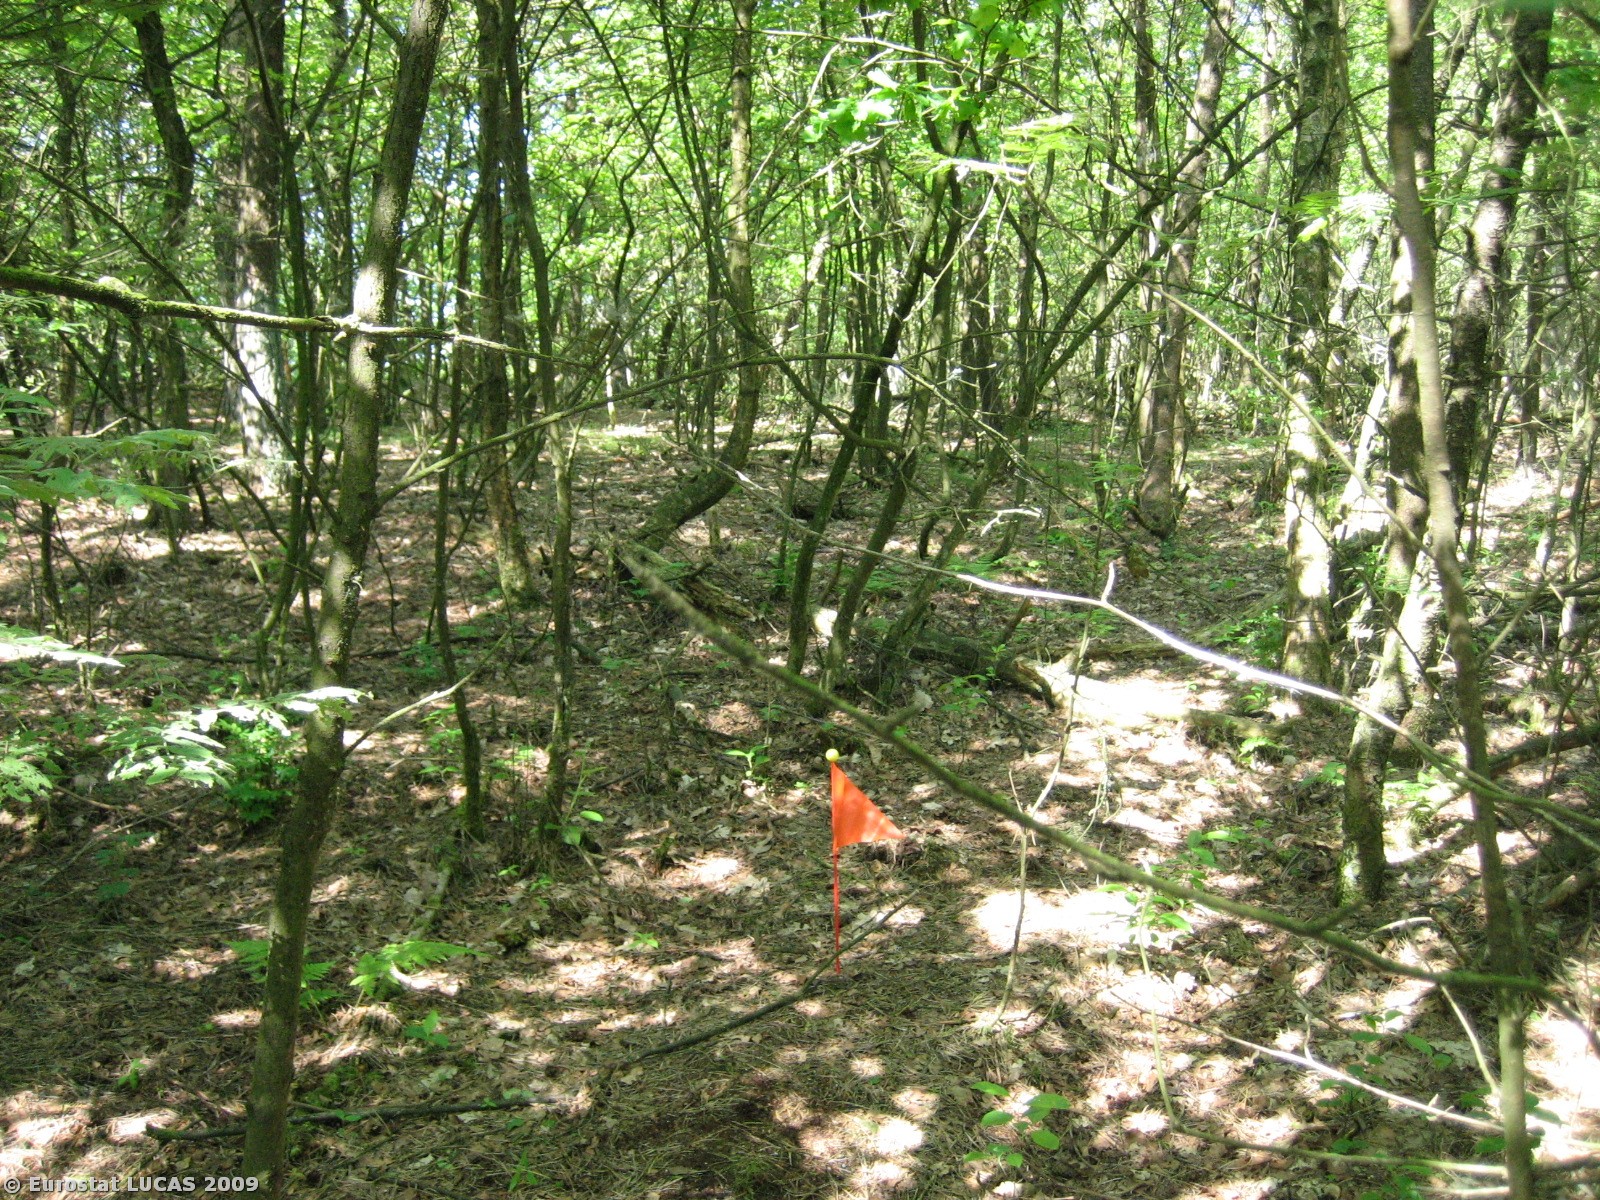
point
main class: Woodland
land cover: Mixed woodland
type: mesophytic deciduous forest
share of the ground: > 75 %
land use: Unused
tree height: > 5 m
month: May
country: DK
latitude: 55.9139
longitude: 8.9612
